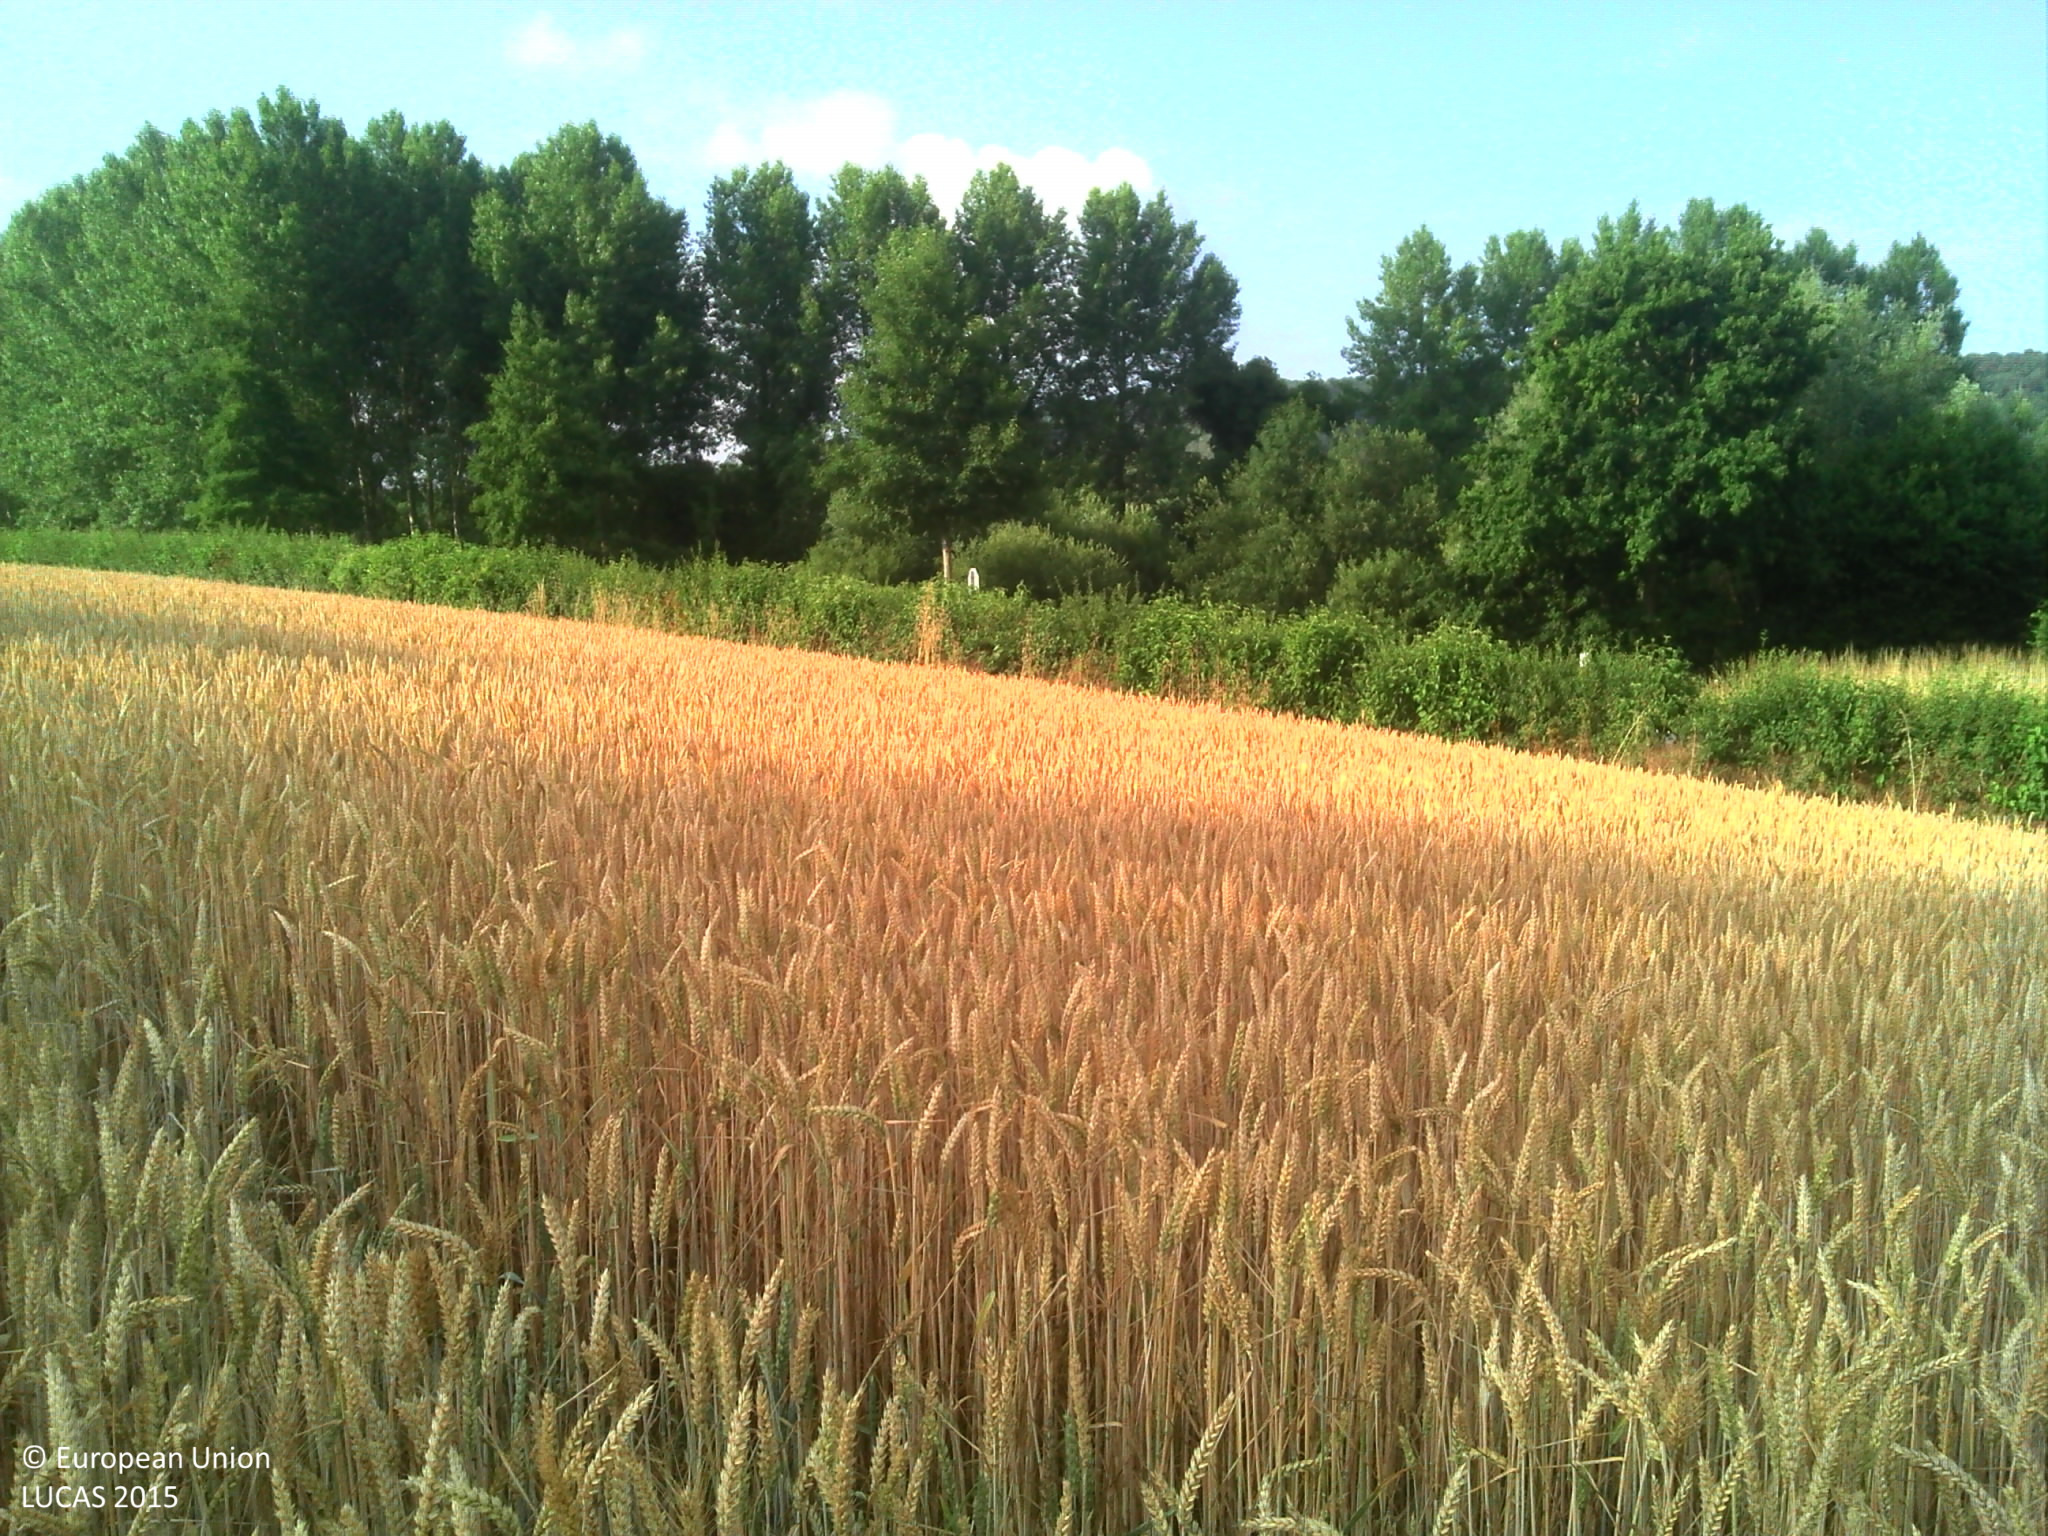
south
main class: Cropland
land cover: Common wheat
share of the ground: > 75 %
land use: Agriculture (excluding fallow land and kitchen gardens)
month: July
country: FR
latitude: 49.8993
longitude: 1.6990
